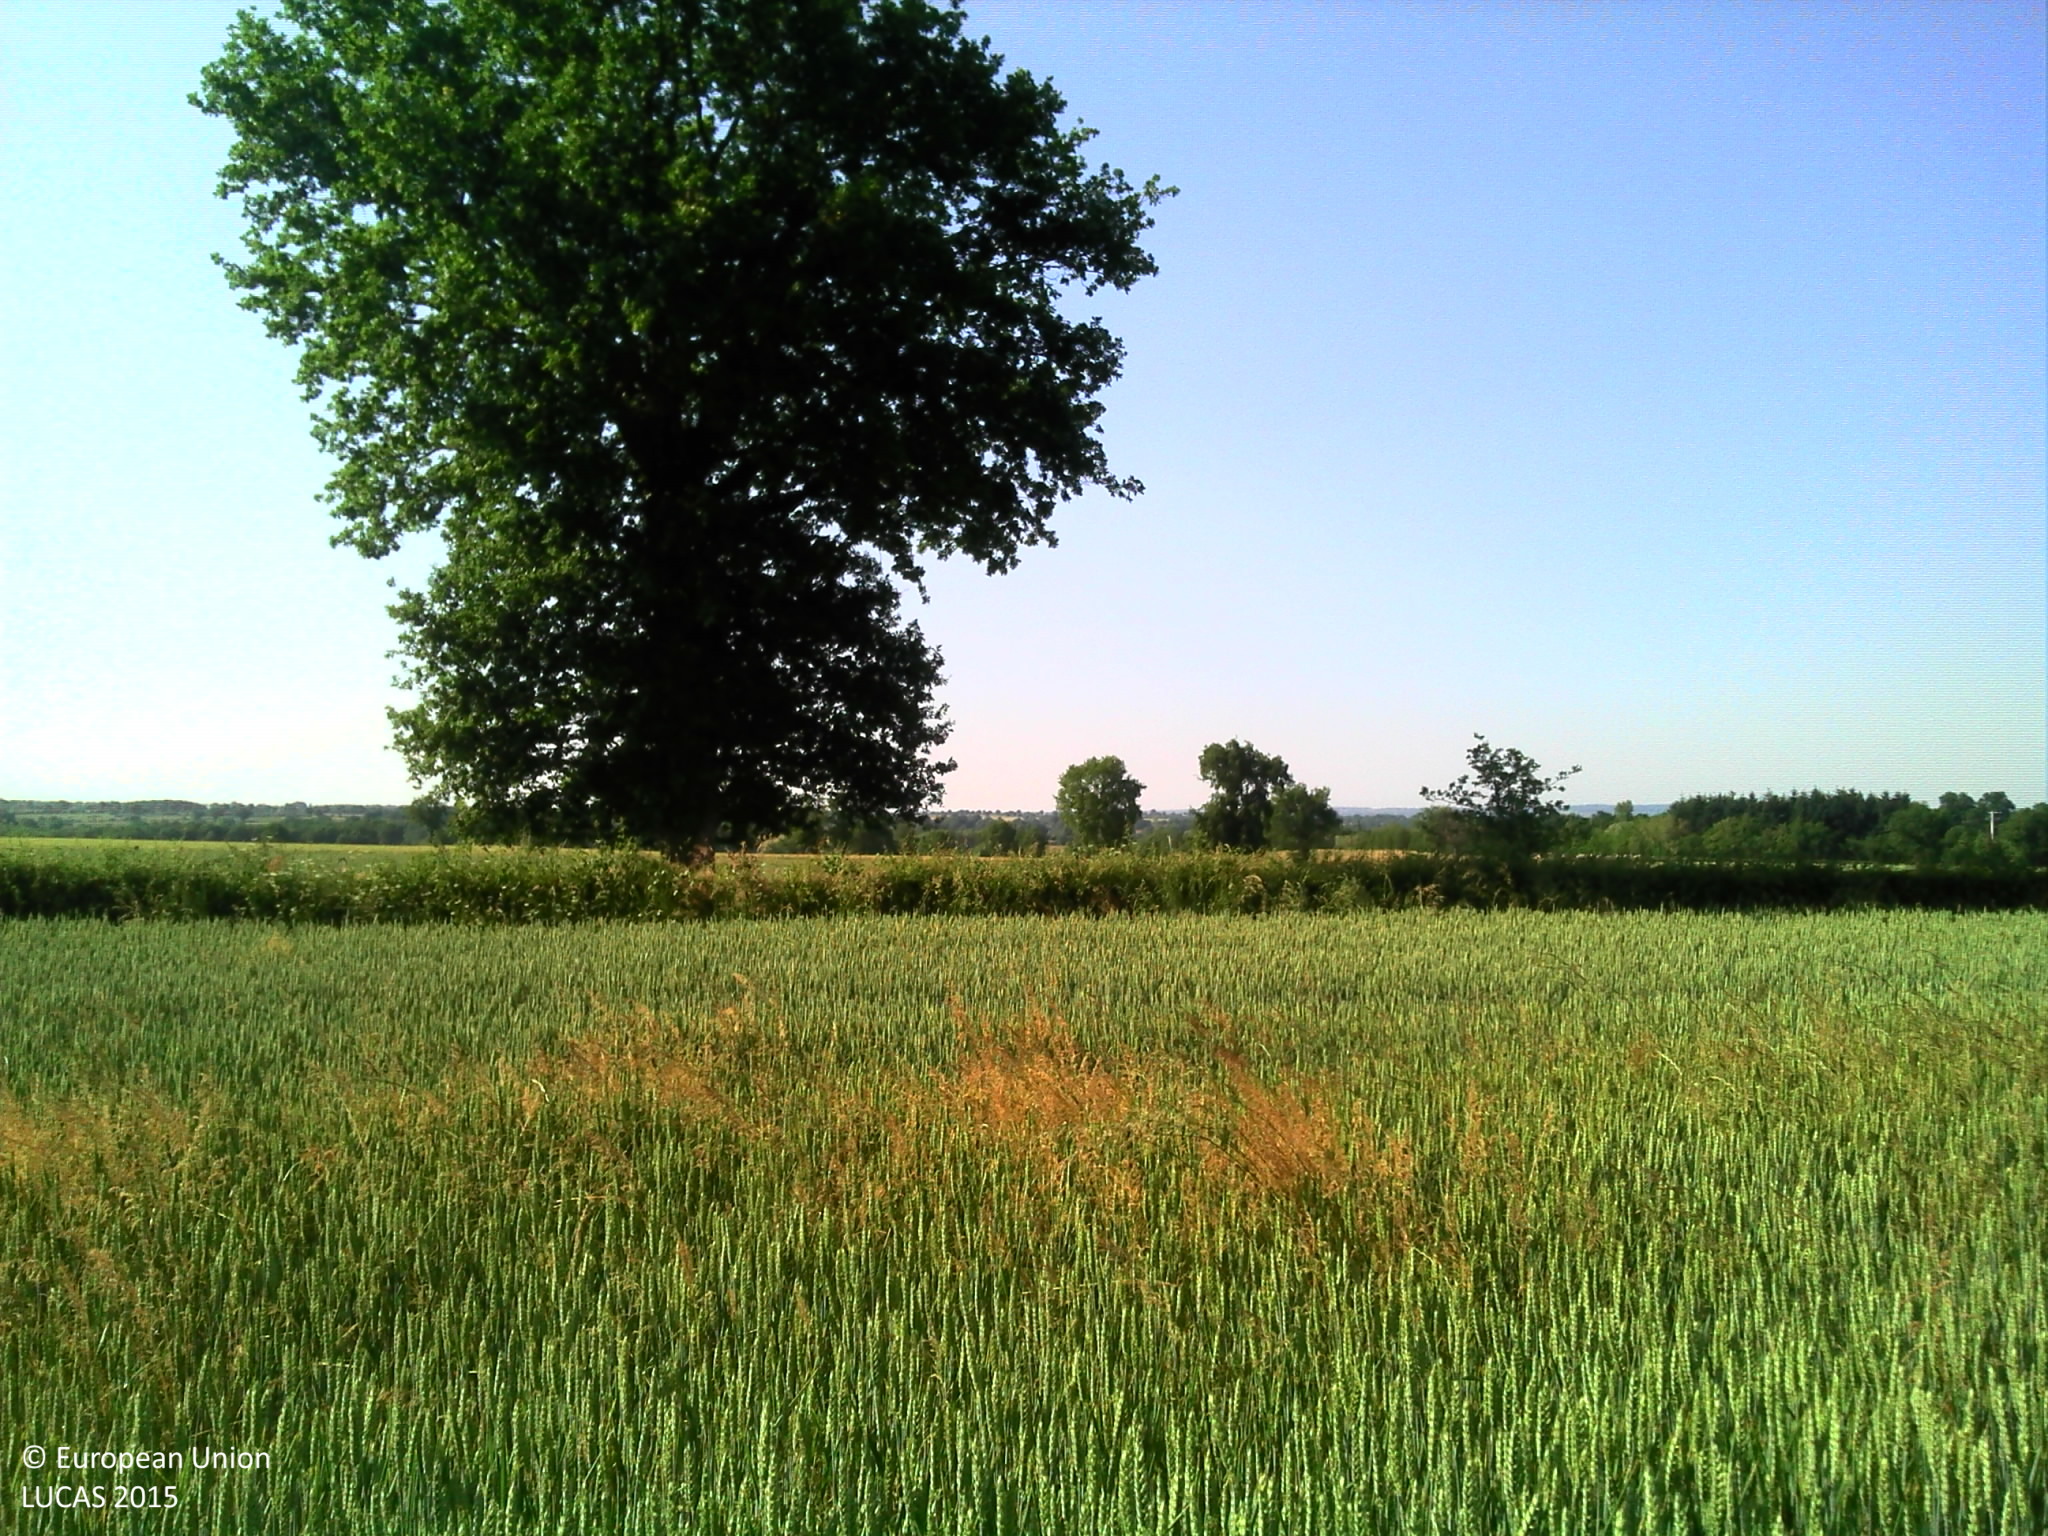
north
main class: Cropland
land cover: Common wheat
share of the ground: > 75 %
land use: Agriculture (excluding fallow land and kitchen gardens)
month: June
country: FR
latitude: 46.3927
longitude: 2.7267
